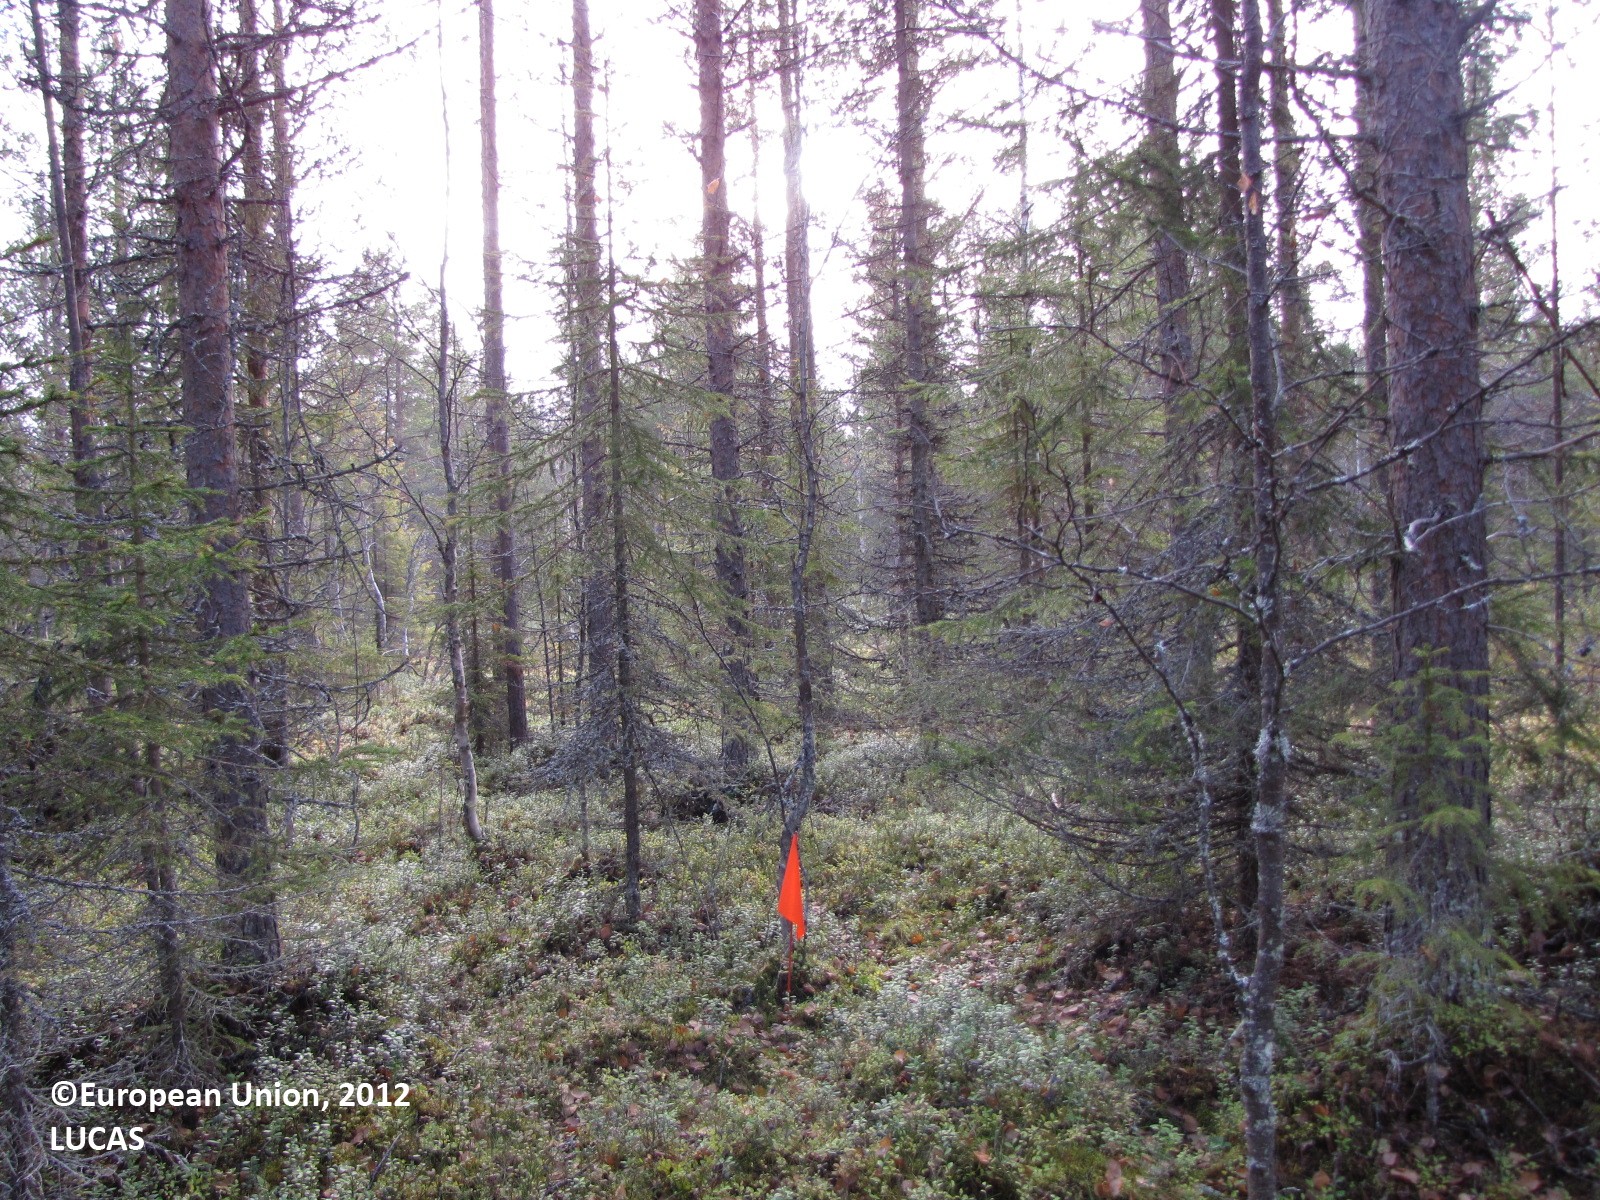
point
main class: Woodland
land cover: Pine dominated coniferous woodland
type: boreal forest
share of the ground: 25 - 50 %
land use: Forestry
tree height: > 5 m
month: September
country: FI
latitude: 67.7322
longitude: 25.1978
